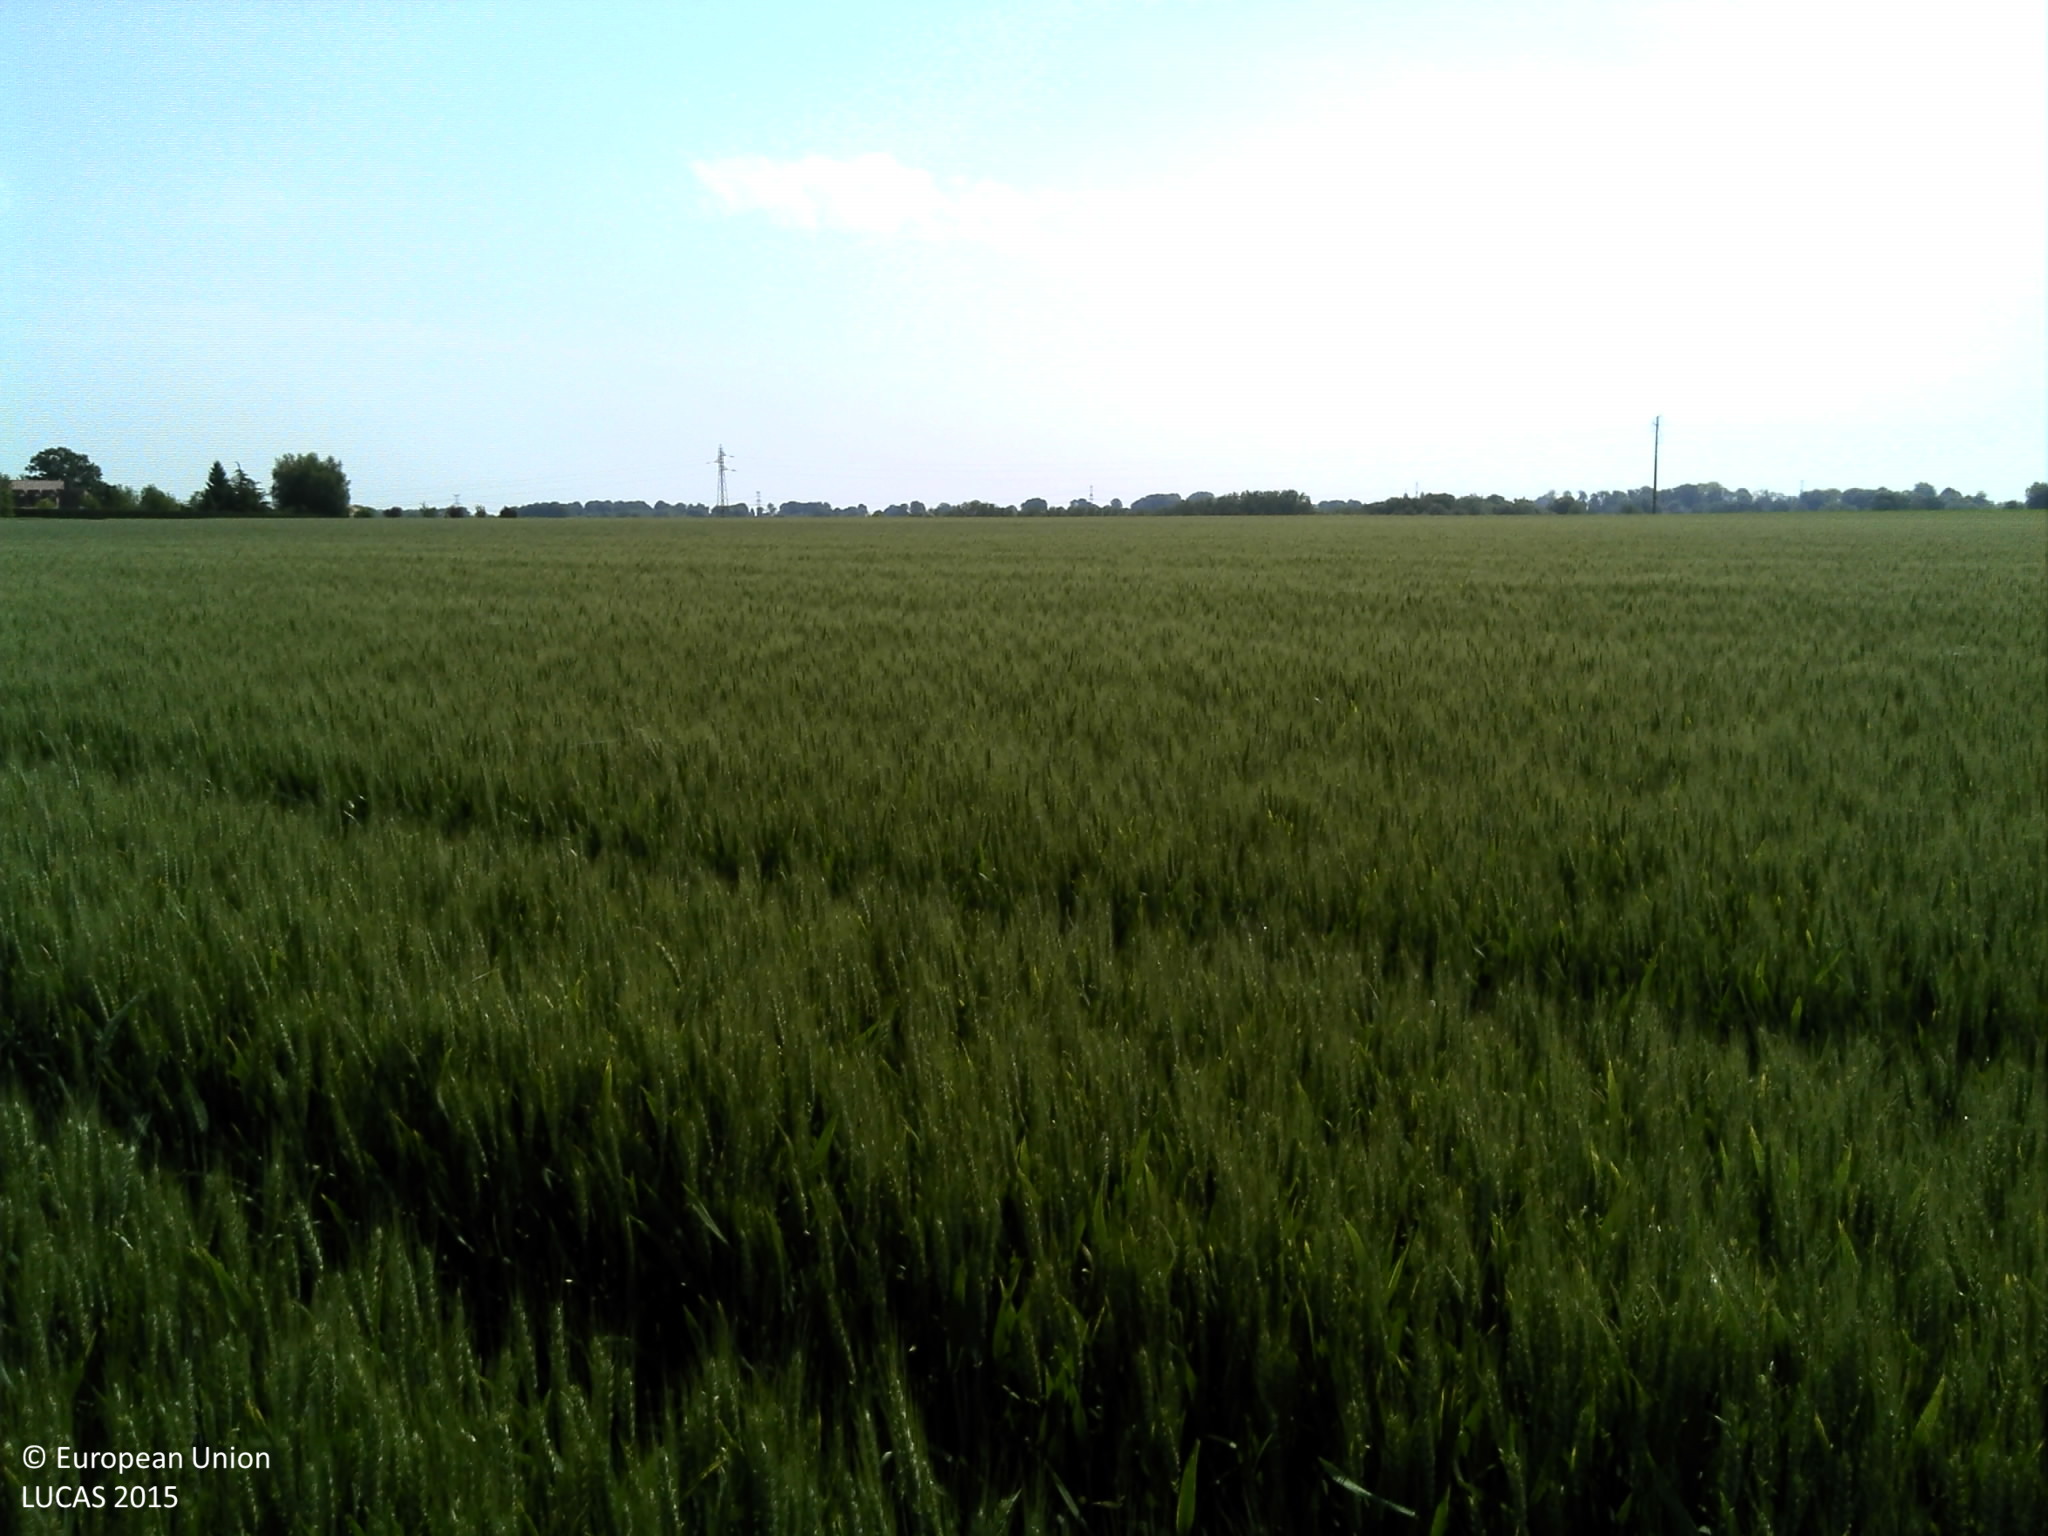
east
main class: Cropland
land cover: Common wheat
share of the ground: > 75 %
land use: Agriculture (excluding fallow land and kitchen gardens)
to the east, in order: Common wheat
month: June
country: FR
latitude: 49.7595
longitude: 1.0519
